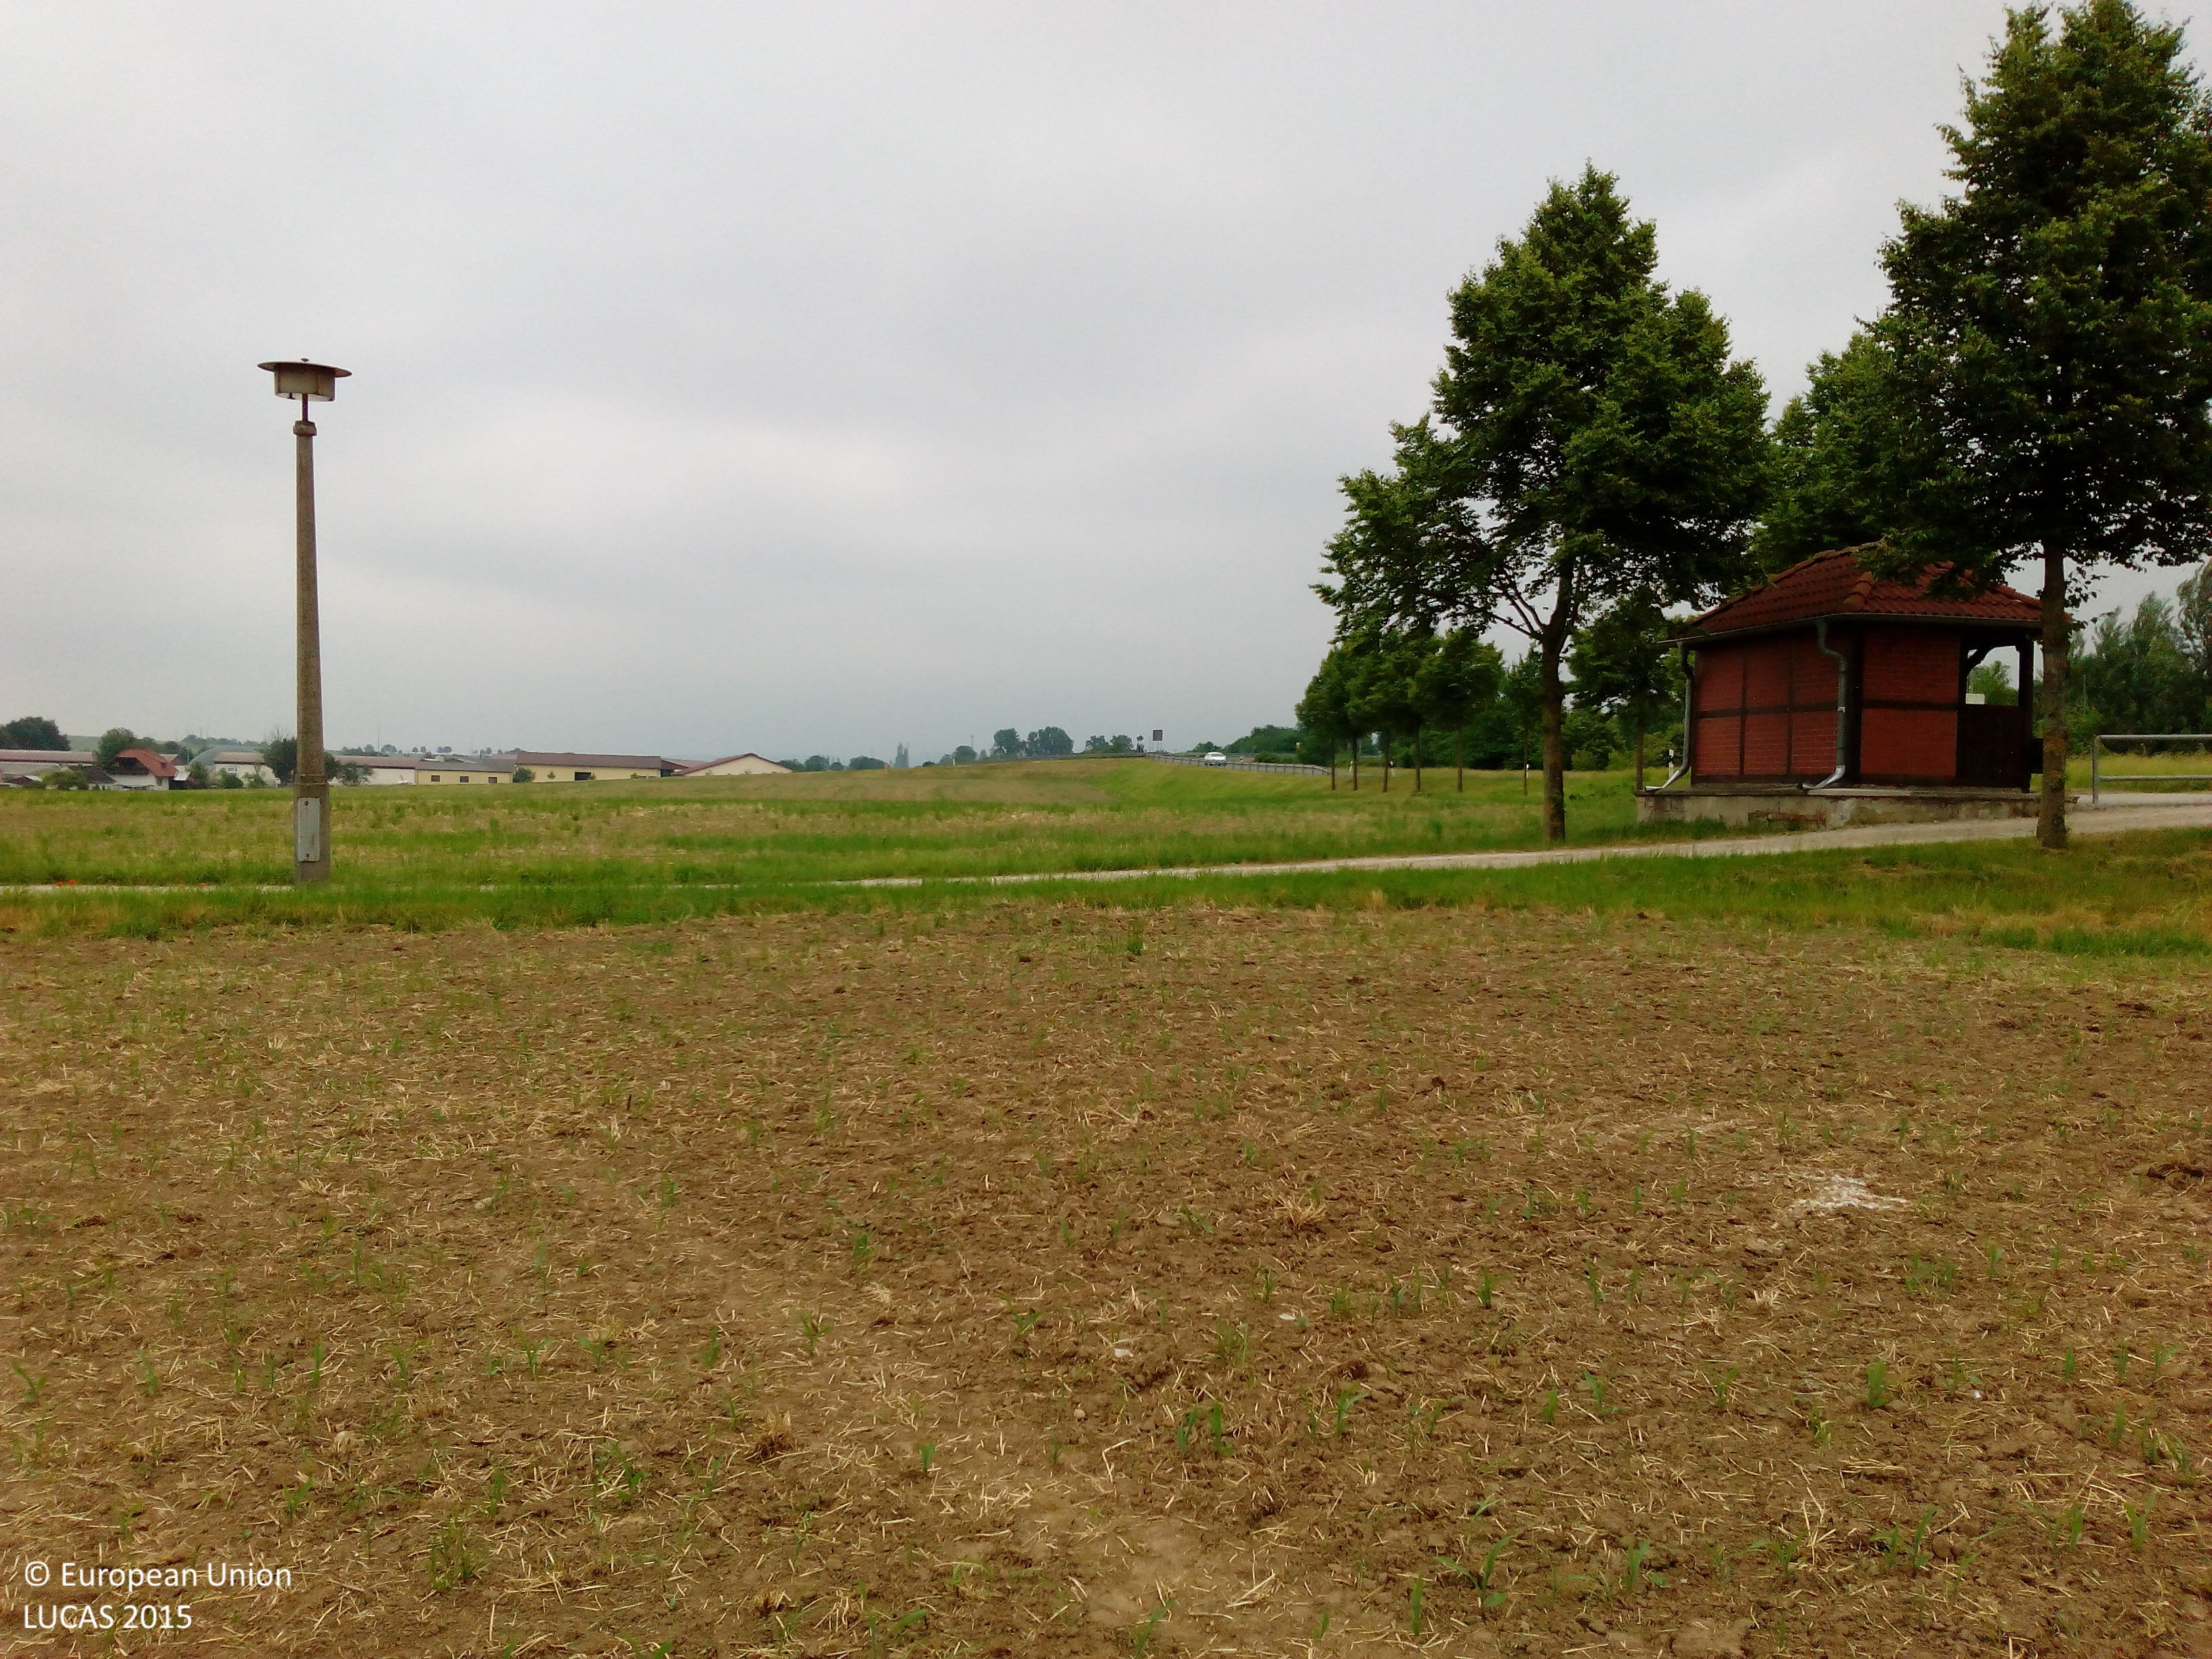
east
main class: Cropland
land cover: Maize
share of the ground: < 10 %
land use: Agriculture (excluding fallow land and kitchen gardens)
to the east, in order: Maize; Grass margins; Tracks; Maize; Grassland without tree/shrub cover; Paved roads, cycling and walking lanes
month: June
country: DE
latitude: 50.6605
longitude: 11.4567
